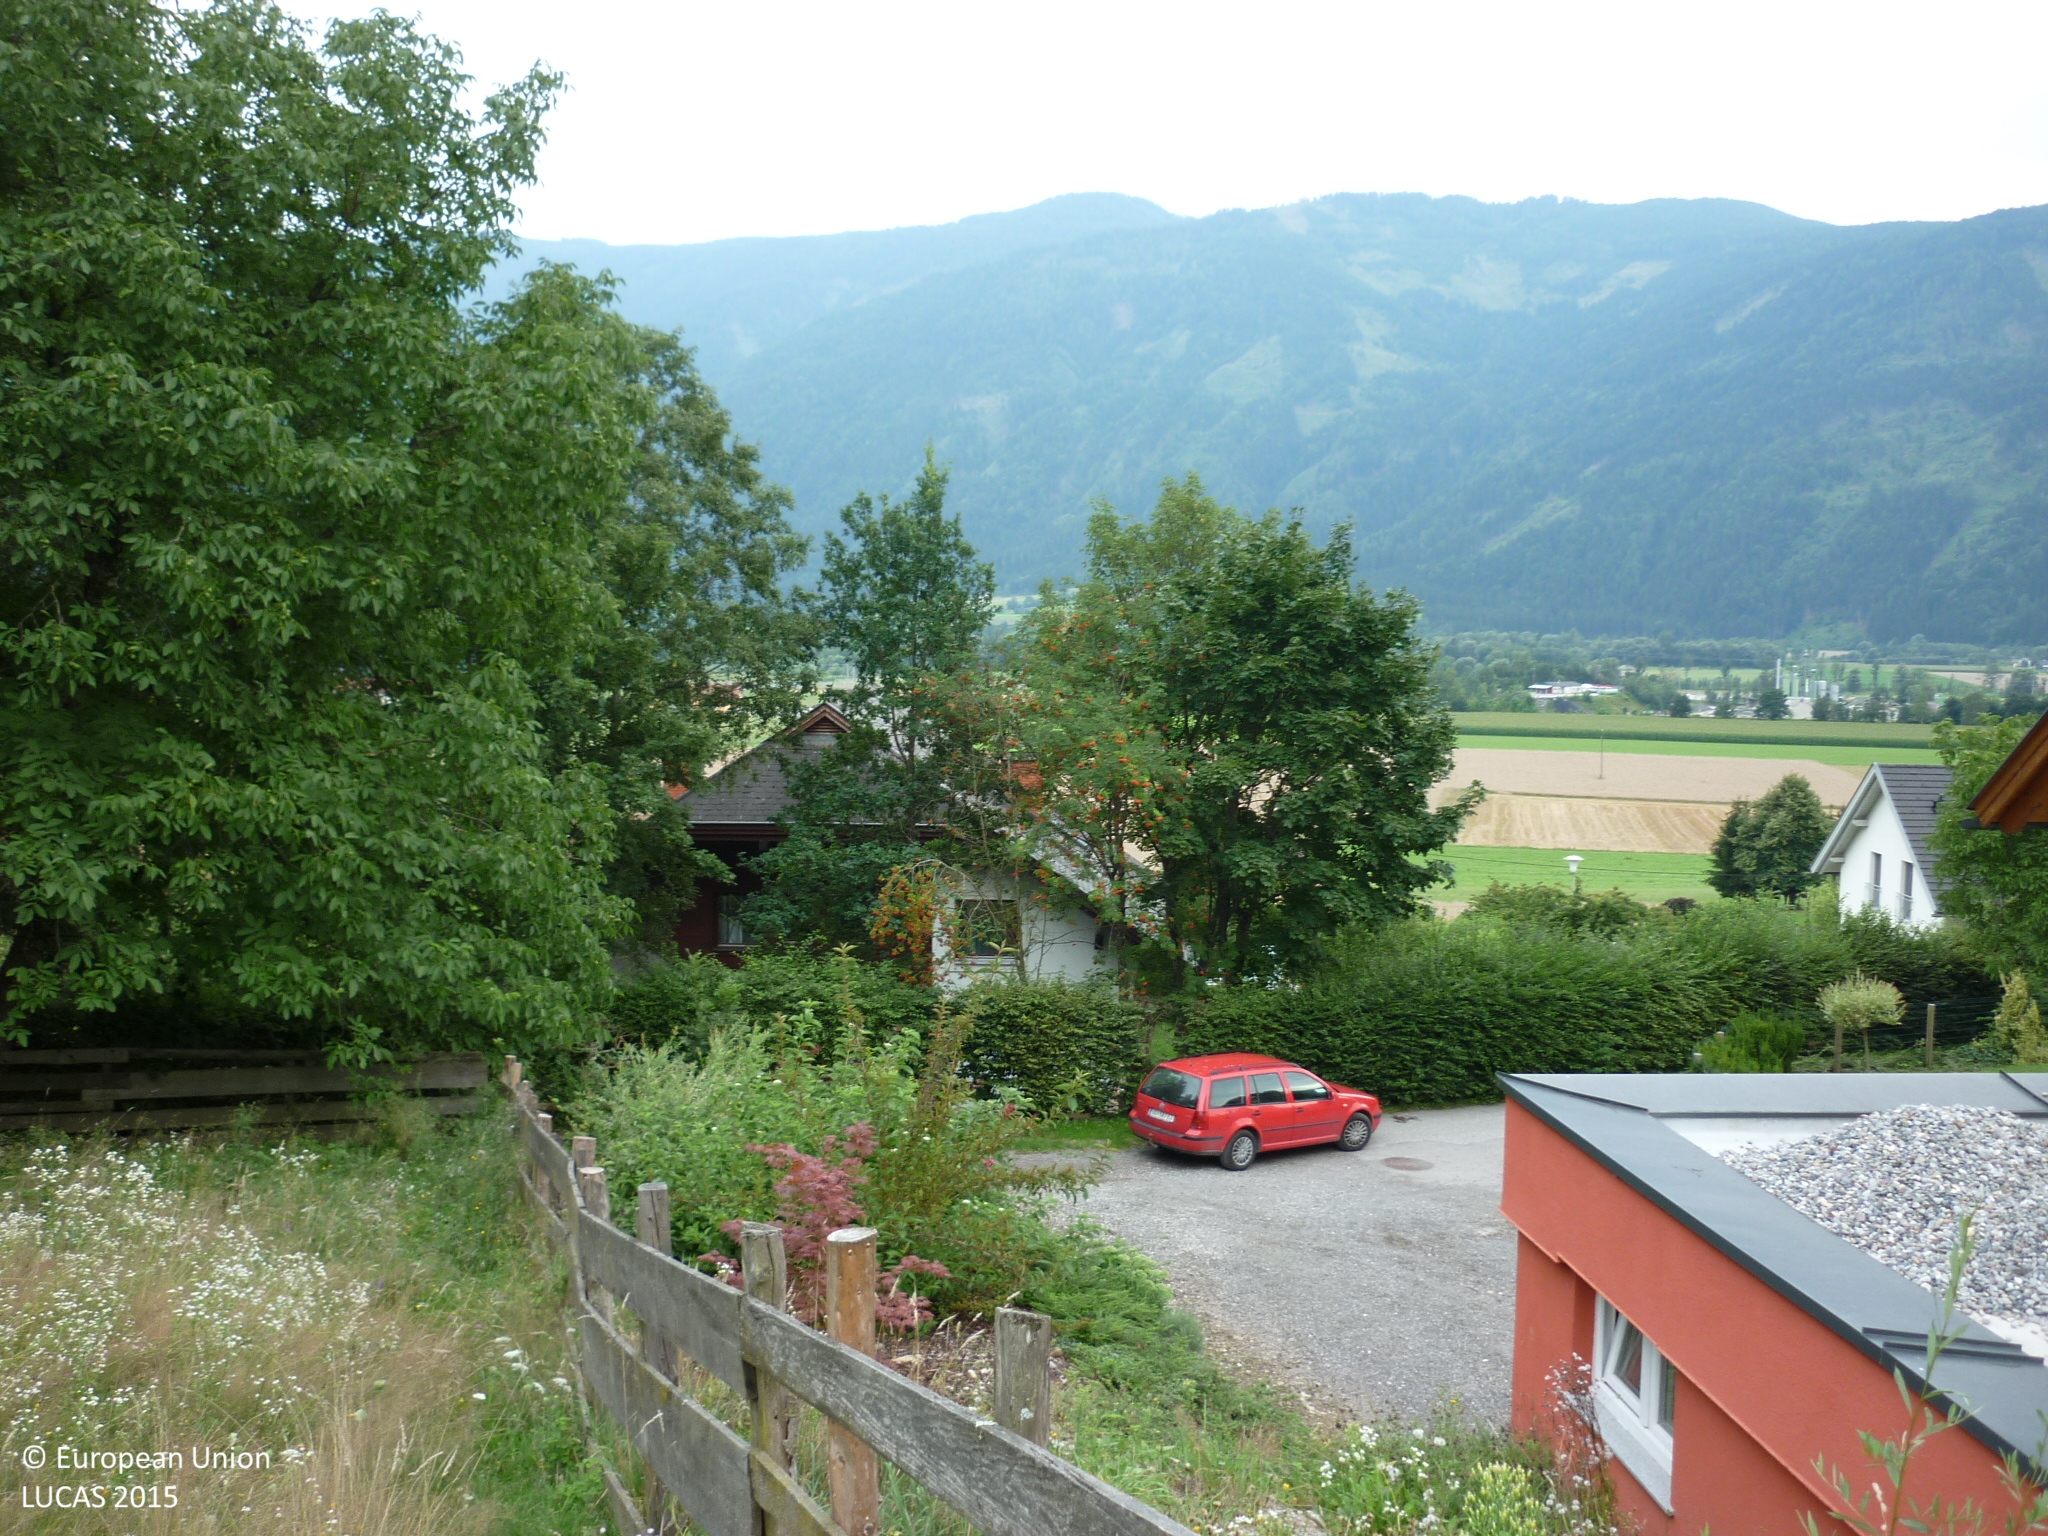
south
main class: Grassland
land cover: Spontaneously vegetated surfaces
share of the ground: > 75 %
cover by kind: herbaceous plants 100 %
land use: Residential
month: August
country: AT
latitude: 46.8373
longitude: 13.4196
